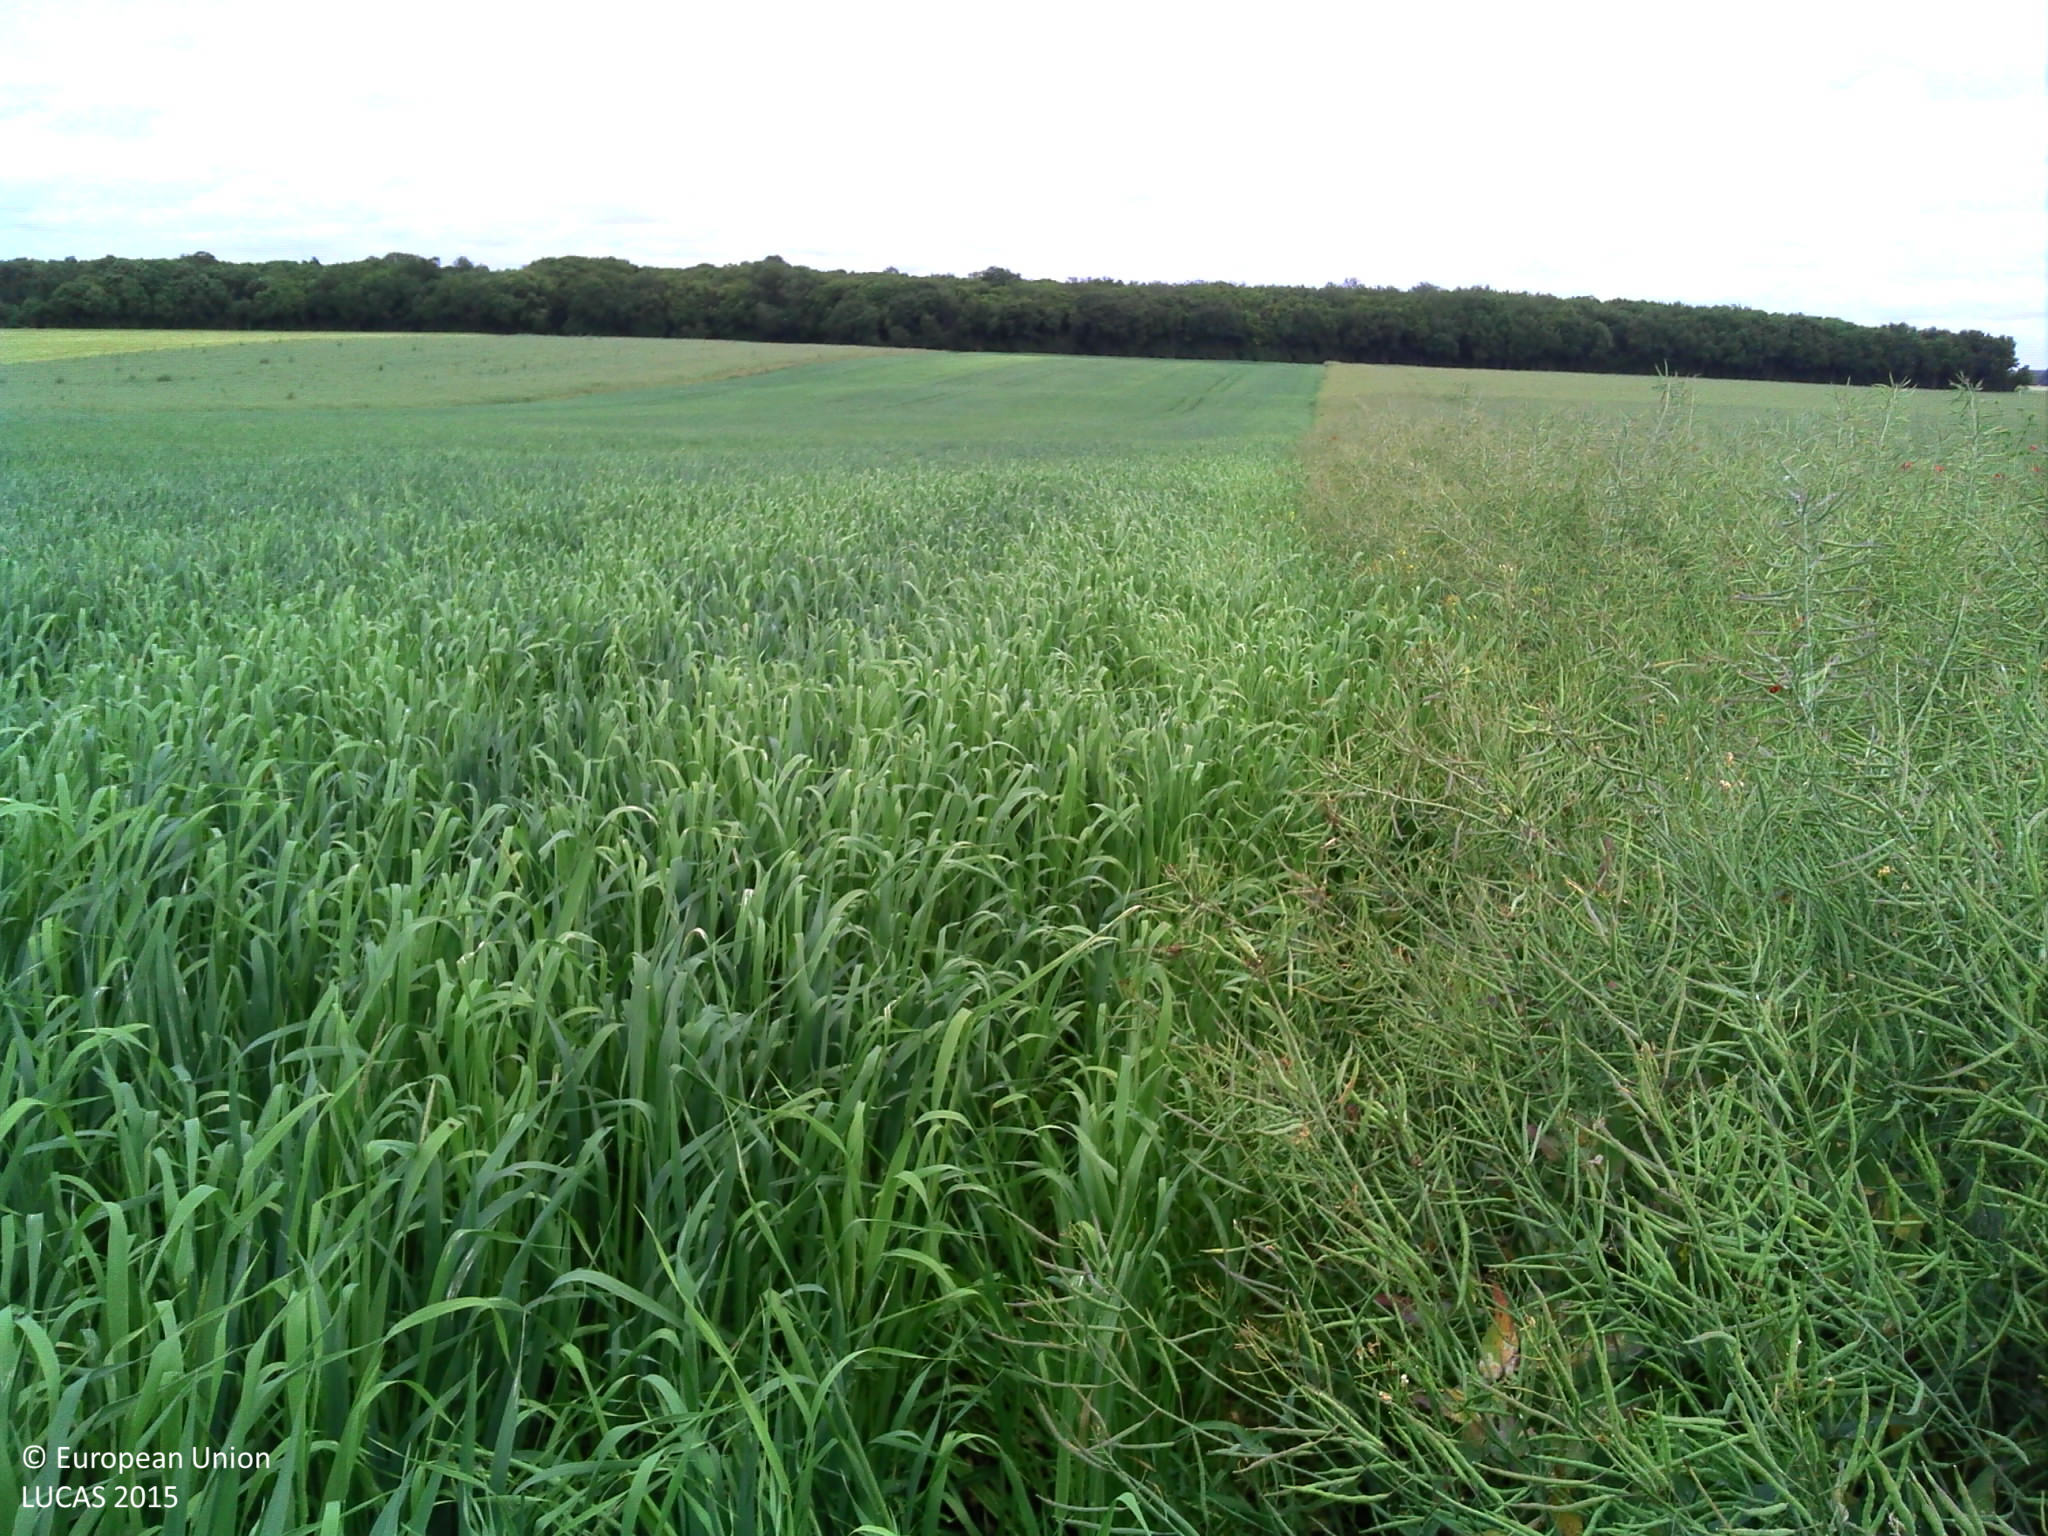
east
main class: Cropland
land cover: Rape and turnip rape
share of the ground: > 75 %
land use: Agriculture (excluding fallow land and kitchen gardens)
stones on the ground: < 10 %
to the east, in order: Rape and turnip rape
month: May
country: FR
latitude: 47.0908
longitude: 2.8945
